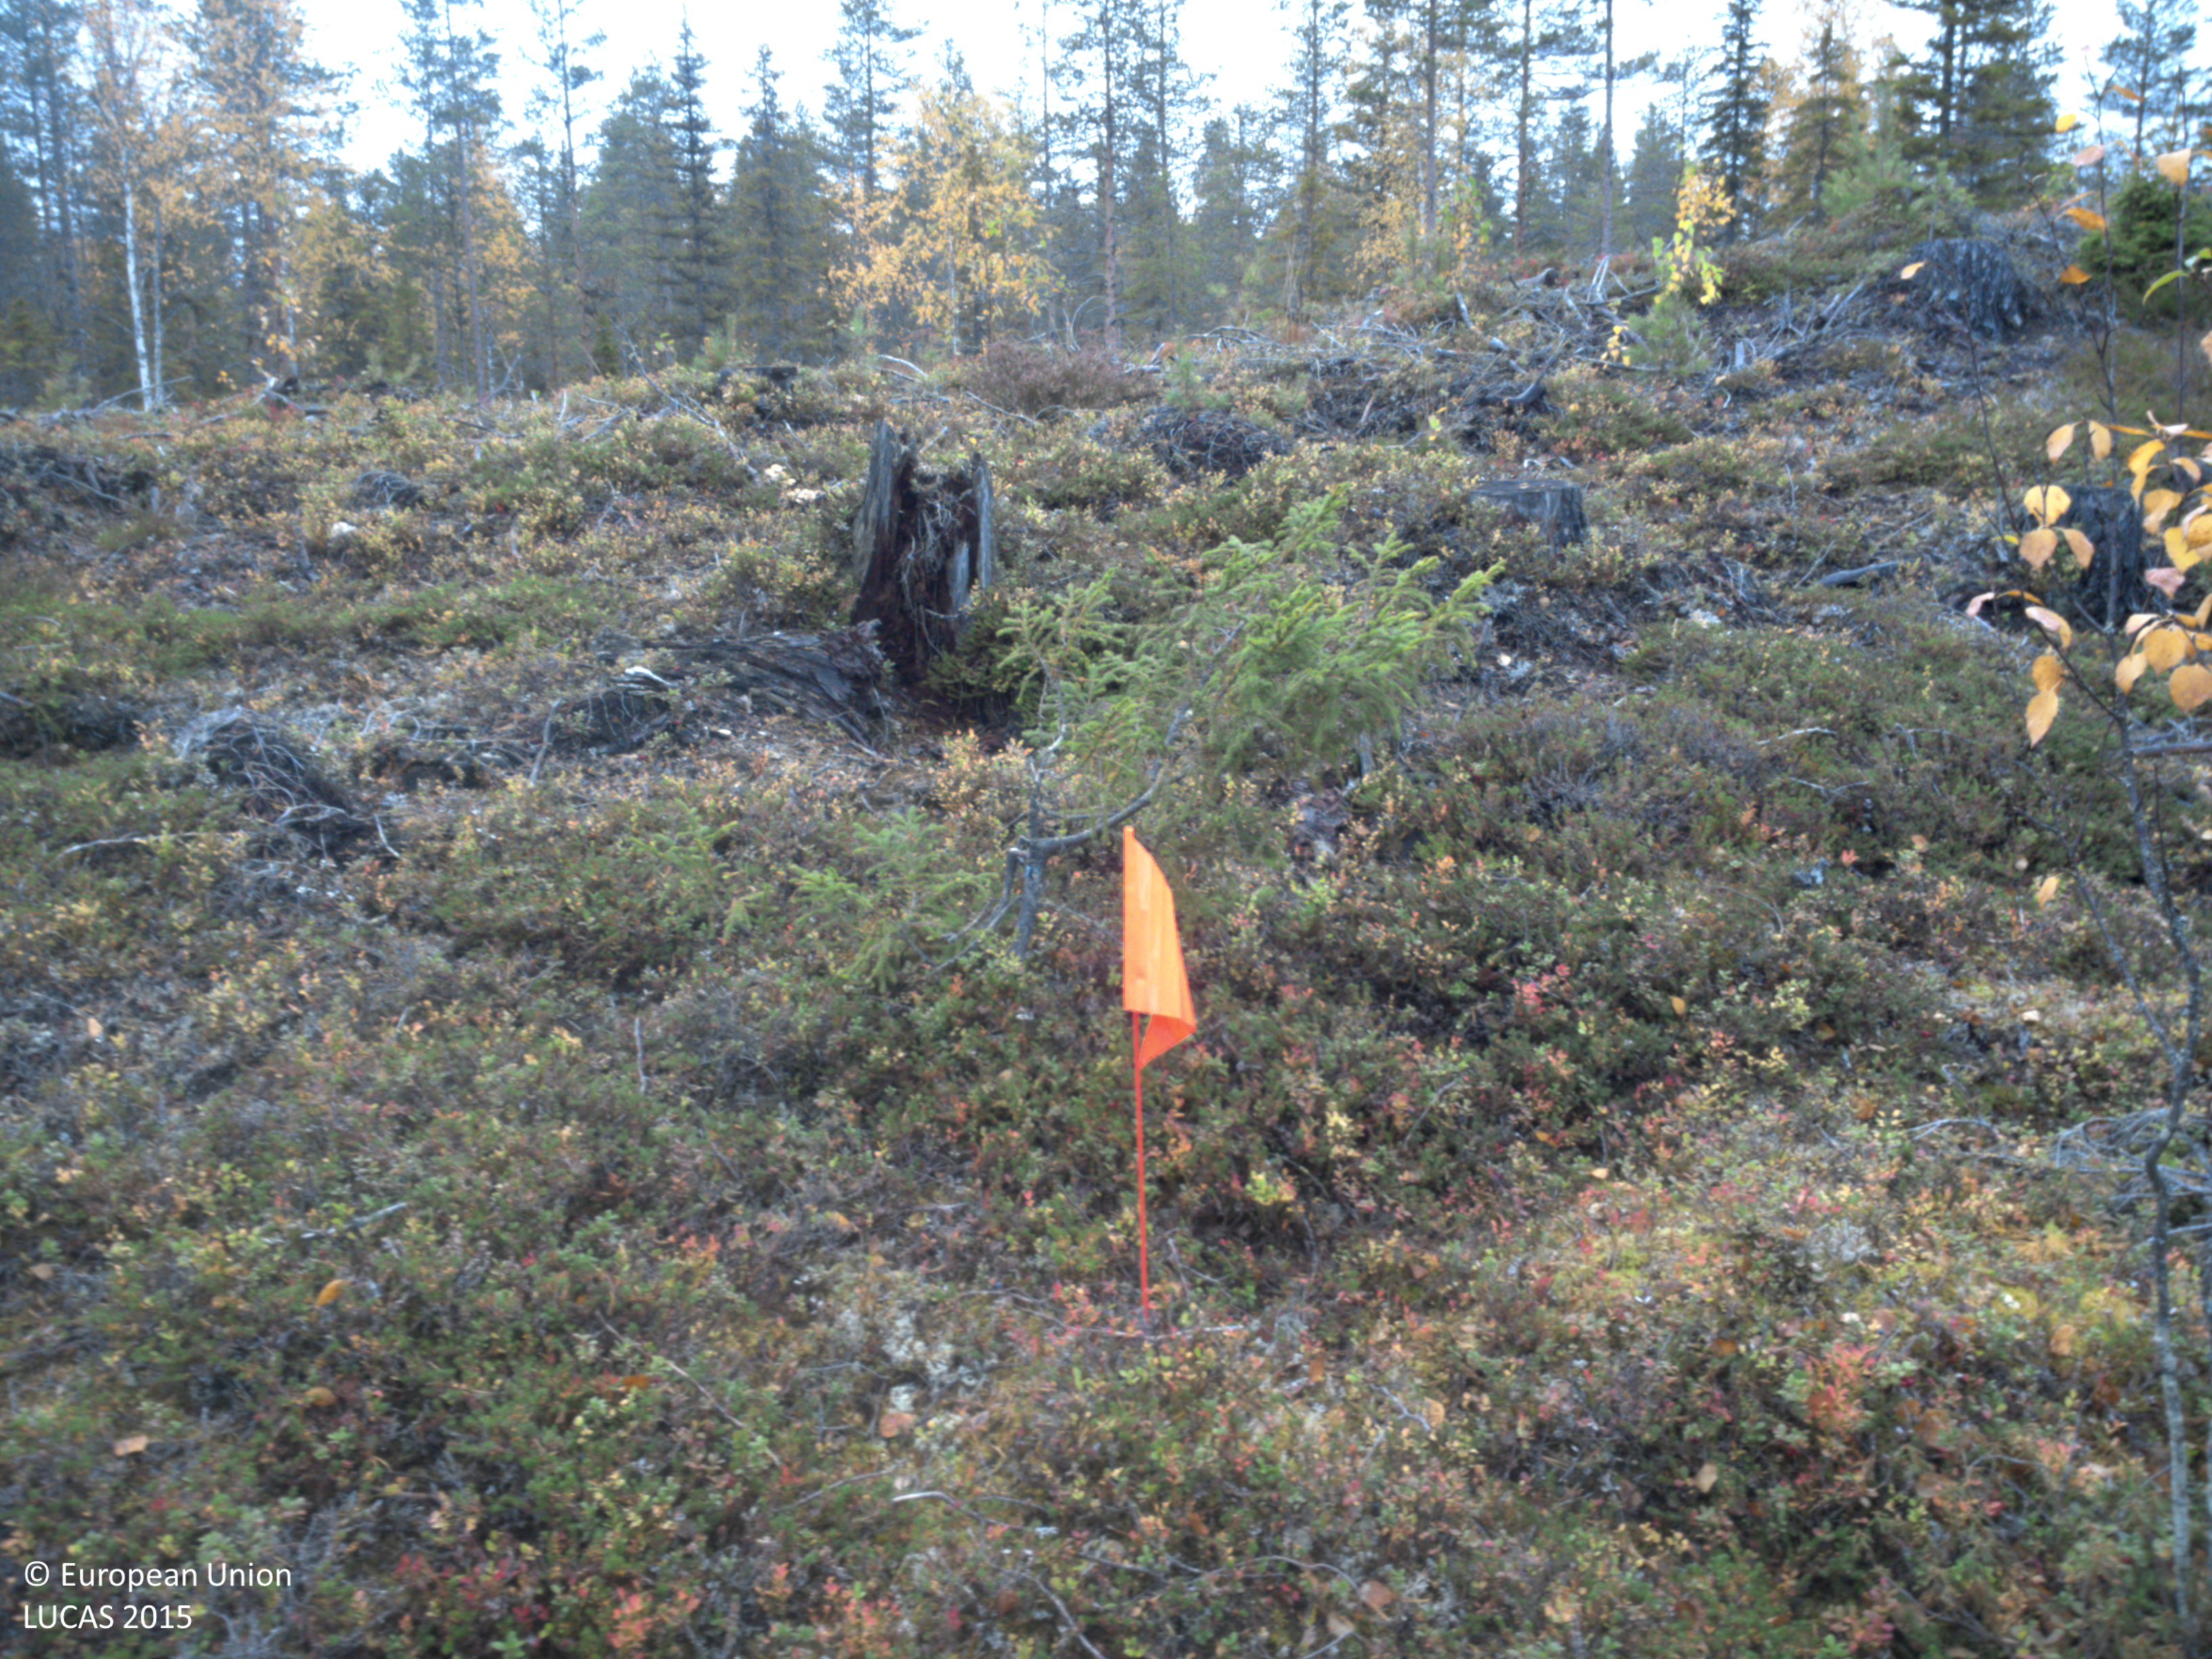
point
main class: Shrubland
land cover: Shrubland with sparse tree cover
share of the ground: > 75 %
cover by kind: shrubs 95 %, coniferous forest trees 5 %
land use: Forestry
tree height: < 5 m
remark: Clear cut
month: September
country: SE
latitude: 64.7670
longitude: 19.8309
